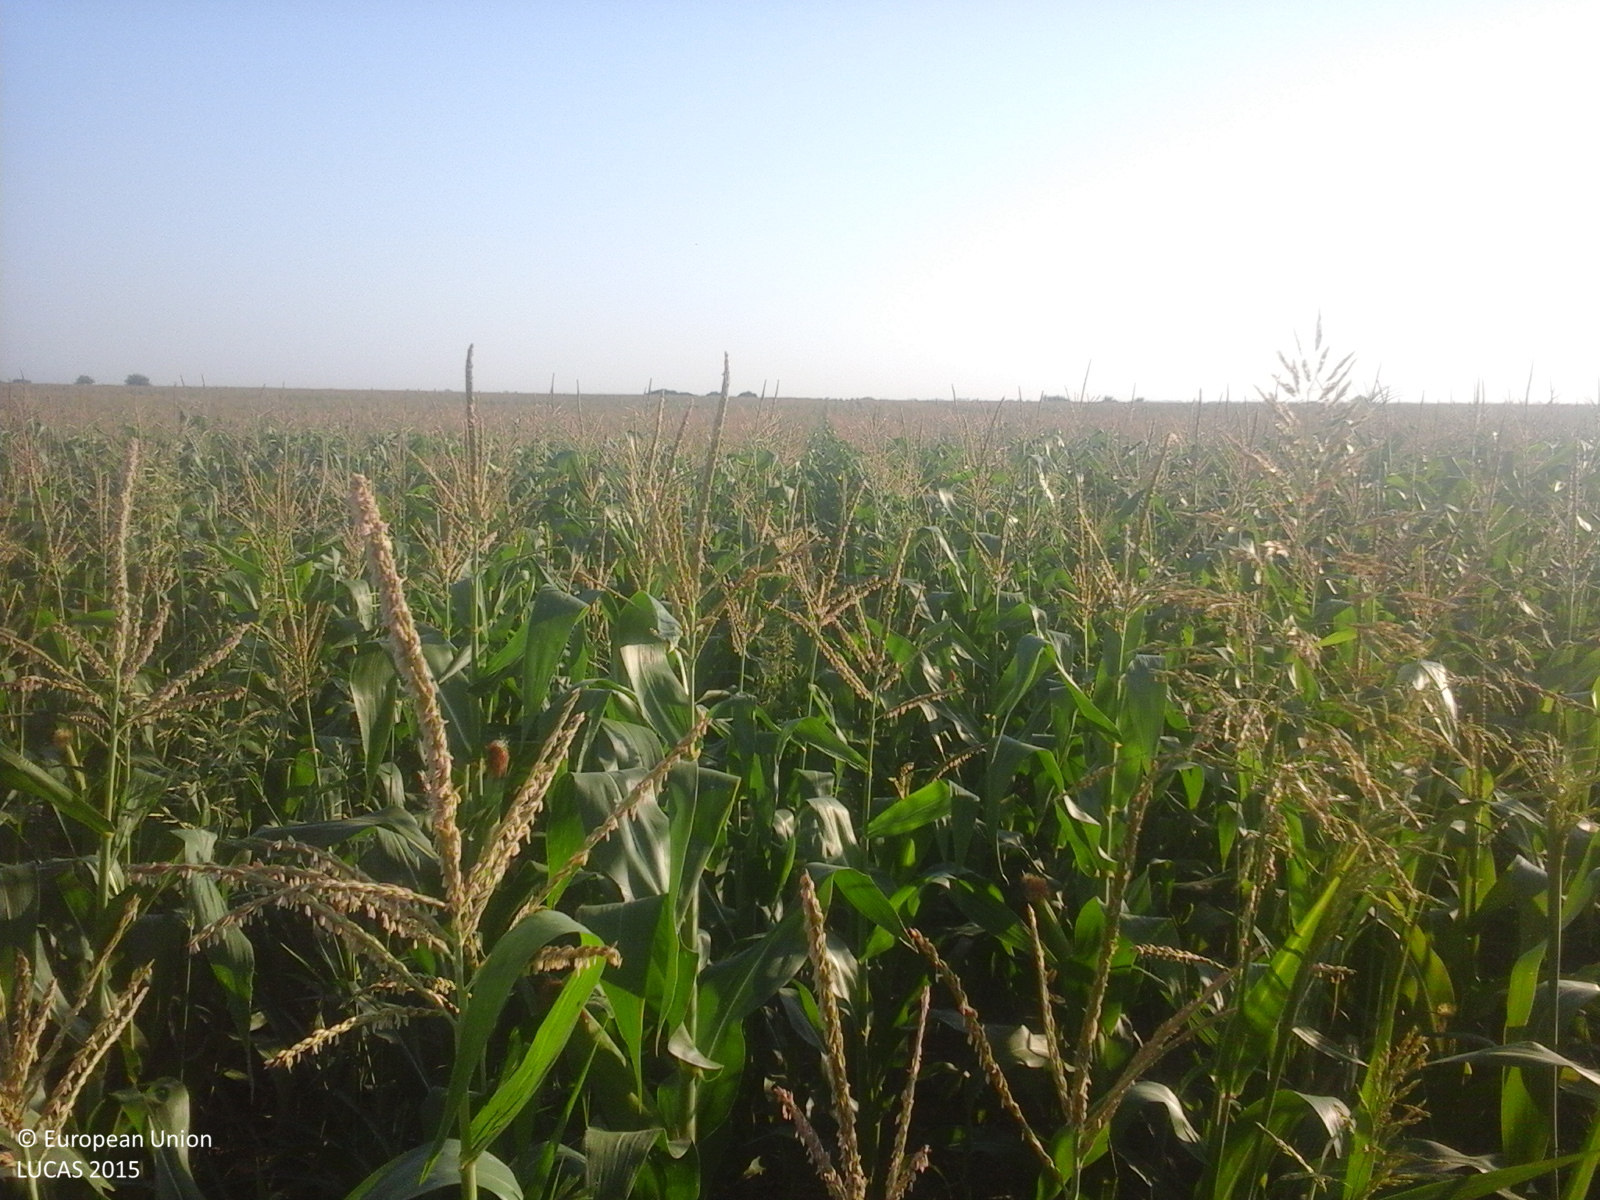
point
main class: Cropland
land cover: Maize
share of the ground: > 75 %
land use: Agriculture (excluding fallow land and kitchen gardens)
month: July
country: RO
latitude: 44.3933
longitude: 27.1940
